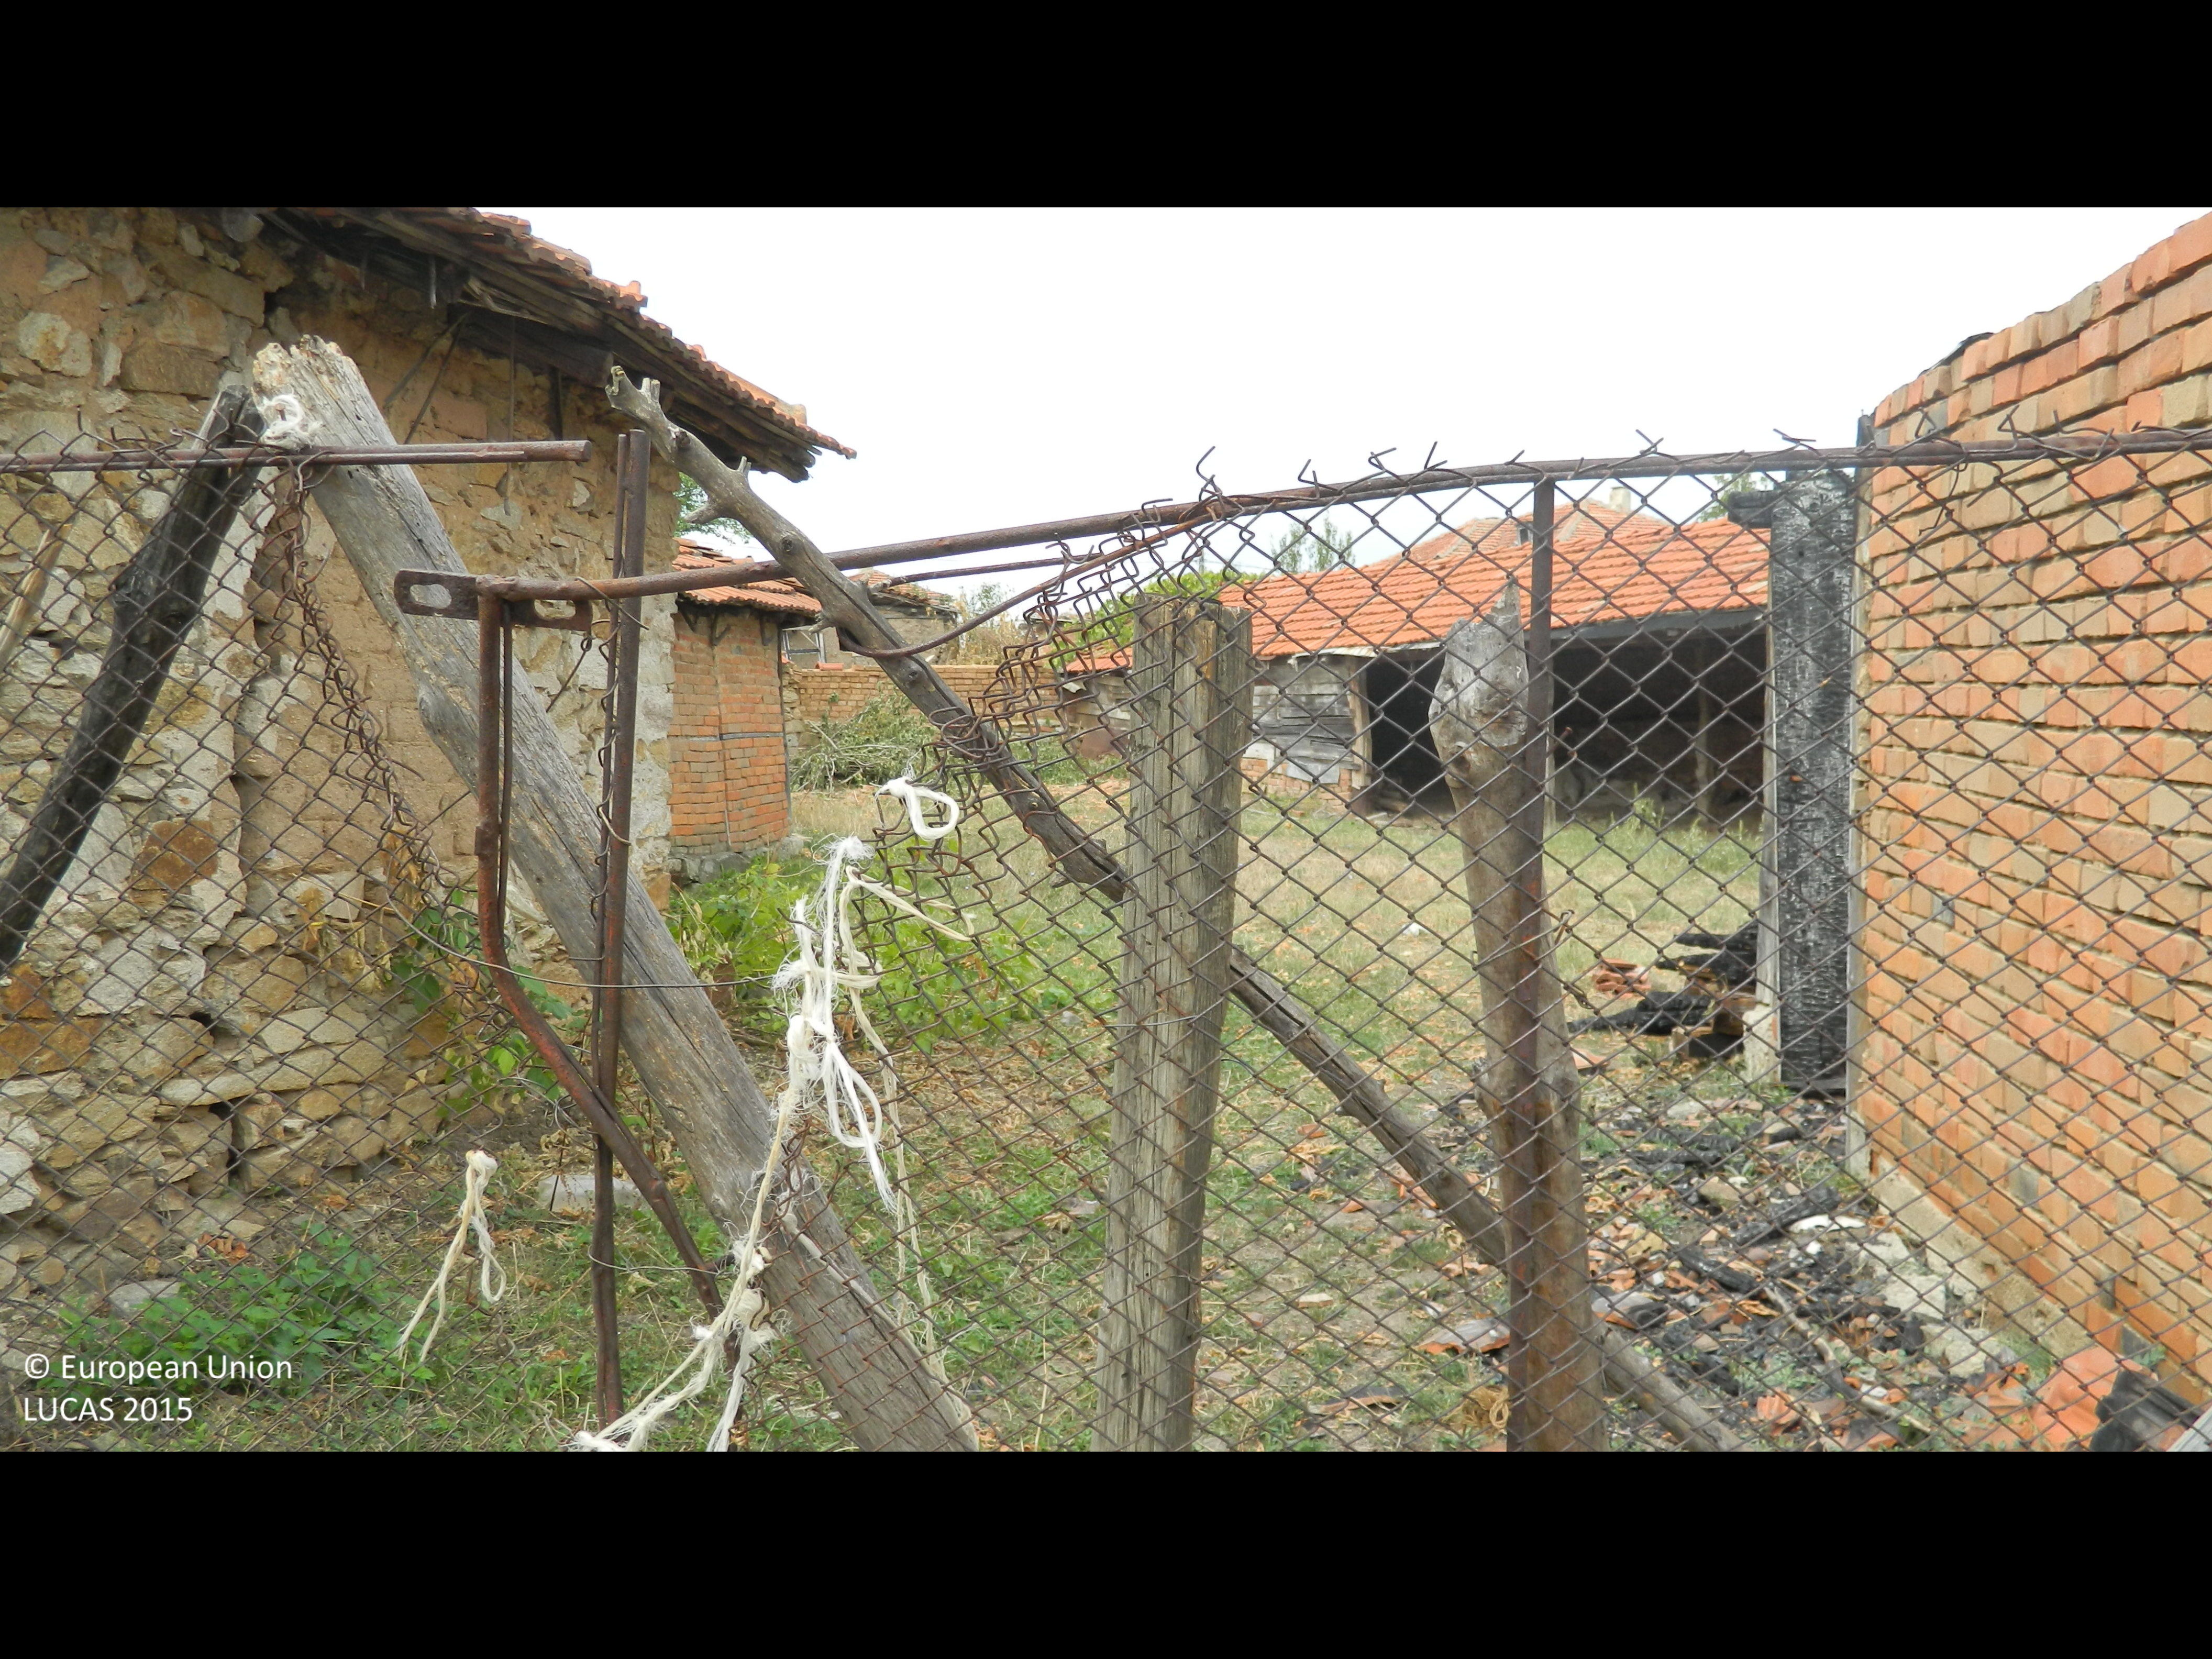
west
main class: Grassland
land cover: Grassland without tree/shrub cover
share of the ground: > 75 %
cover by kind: herbaceous plants 95 %, unconsolidated bare surface 5 %
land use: Residential
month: September
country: BG
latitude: 41.8416
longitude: 25.7100
